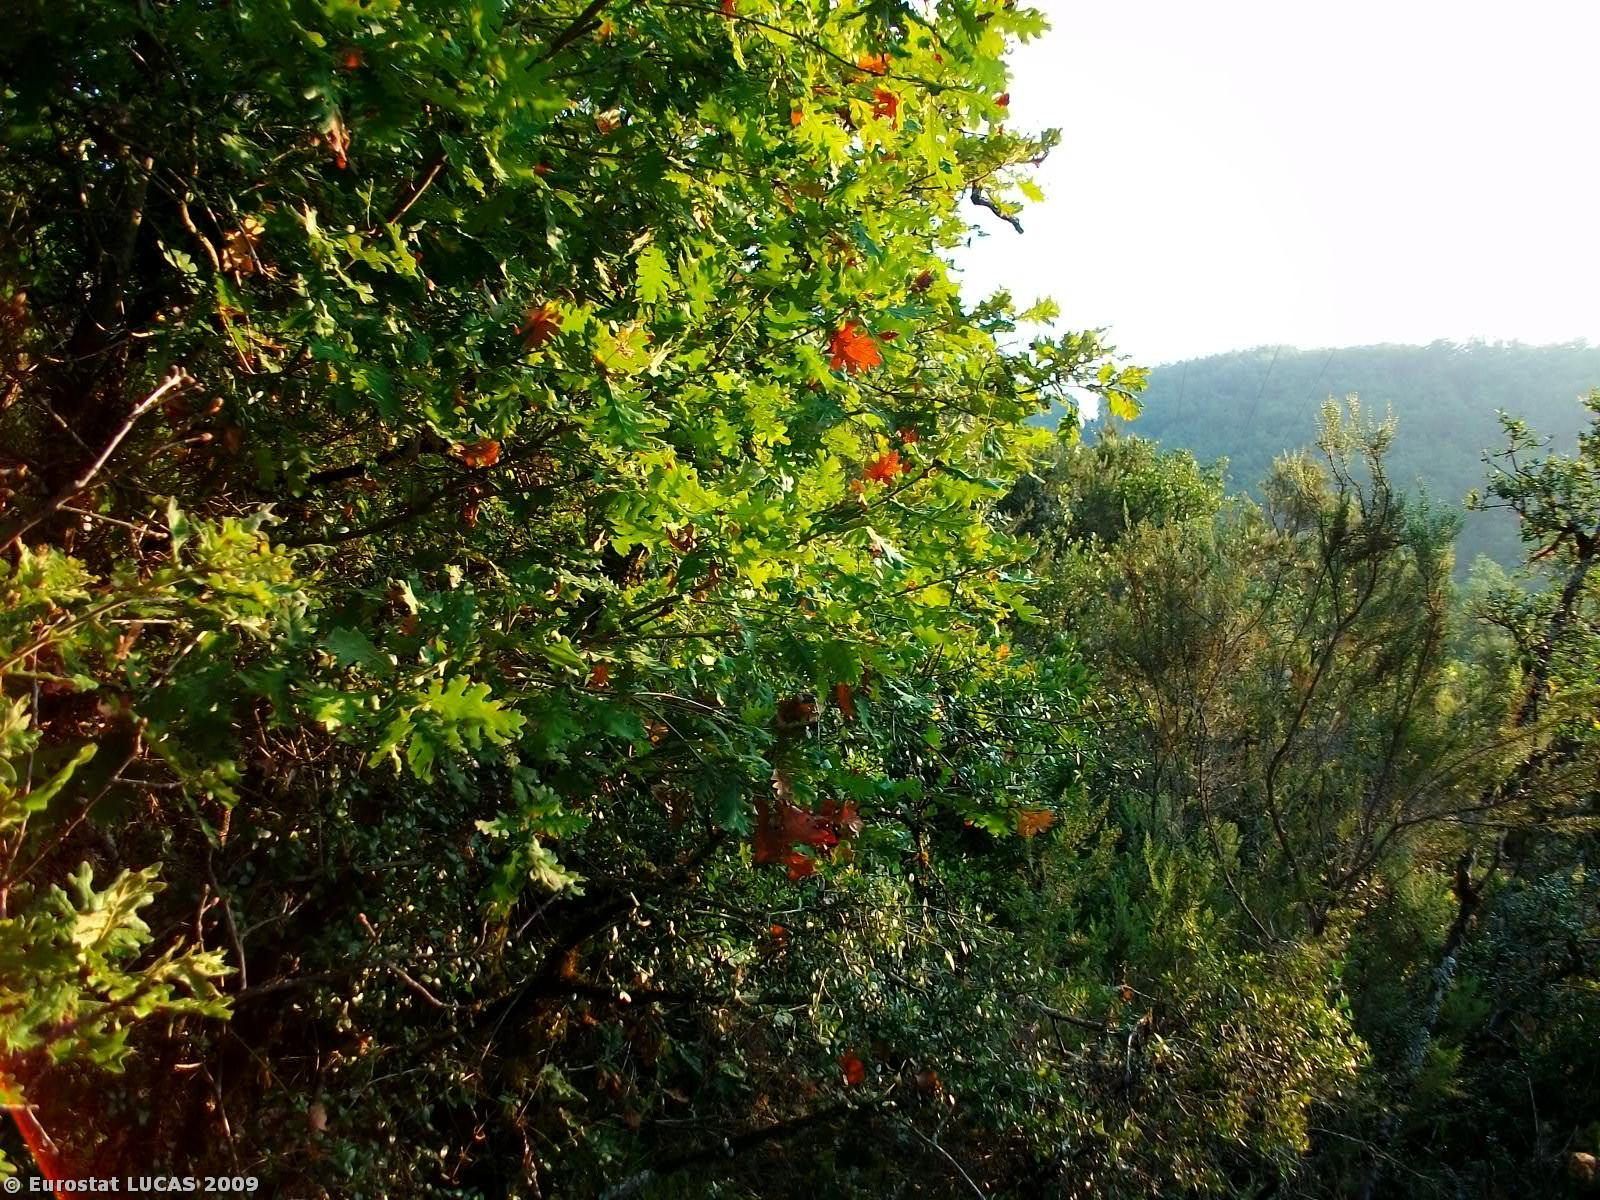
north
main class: Woodland
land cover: Broadleaved woodland
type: thermophilous deciduous forest
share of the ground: > 75 %
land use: Forestry
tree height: > 5 m
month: September
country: GR
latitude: 39.7039
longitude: 20.4853
